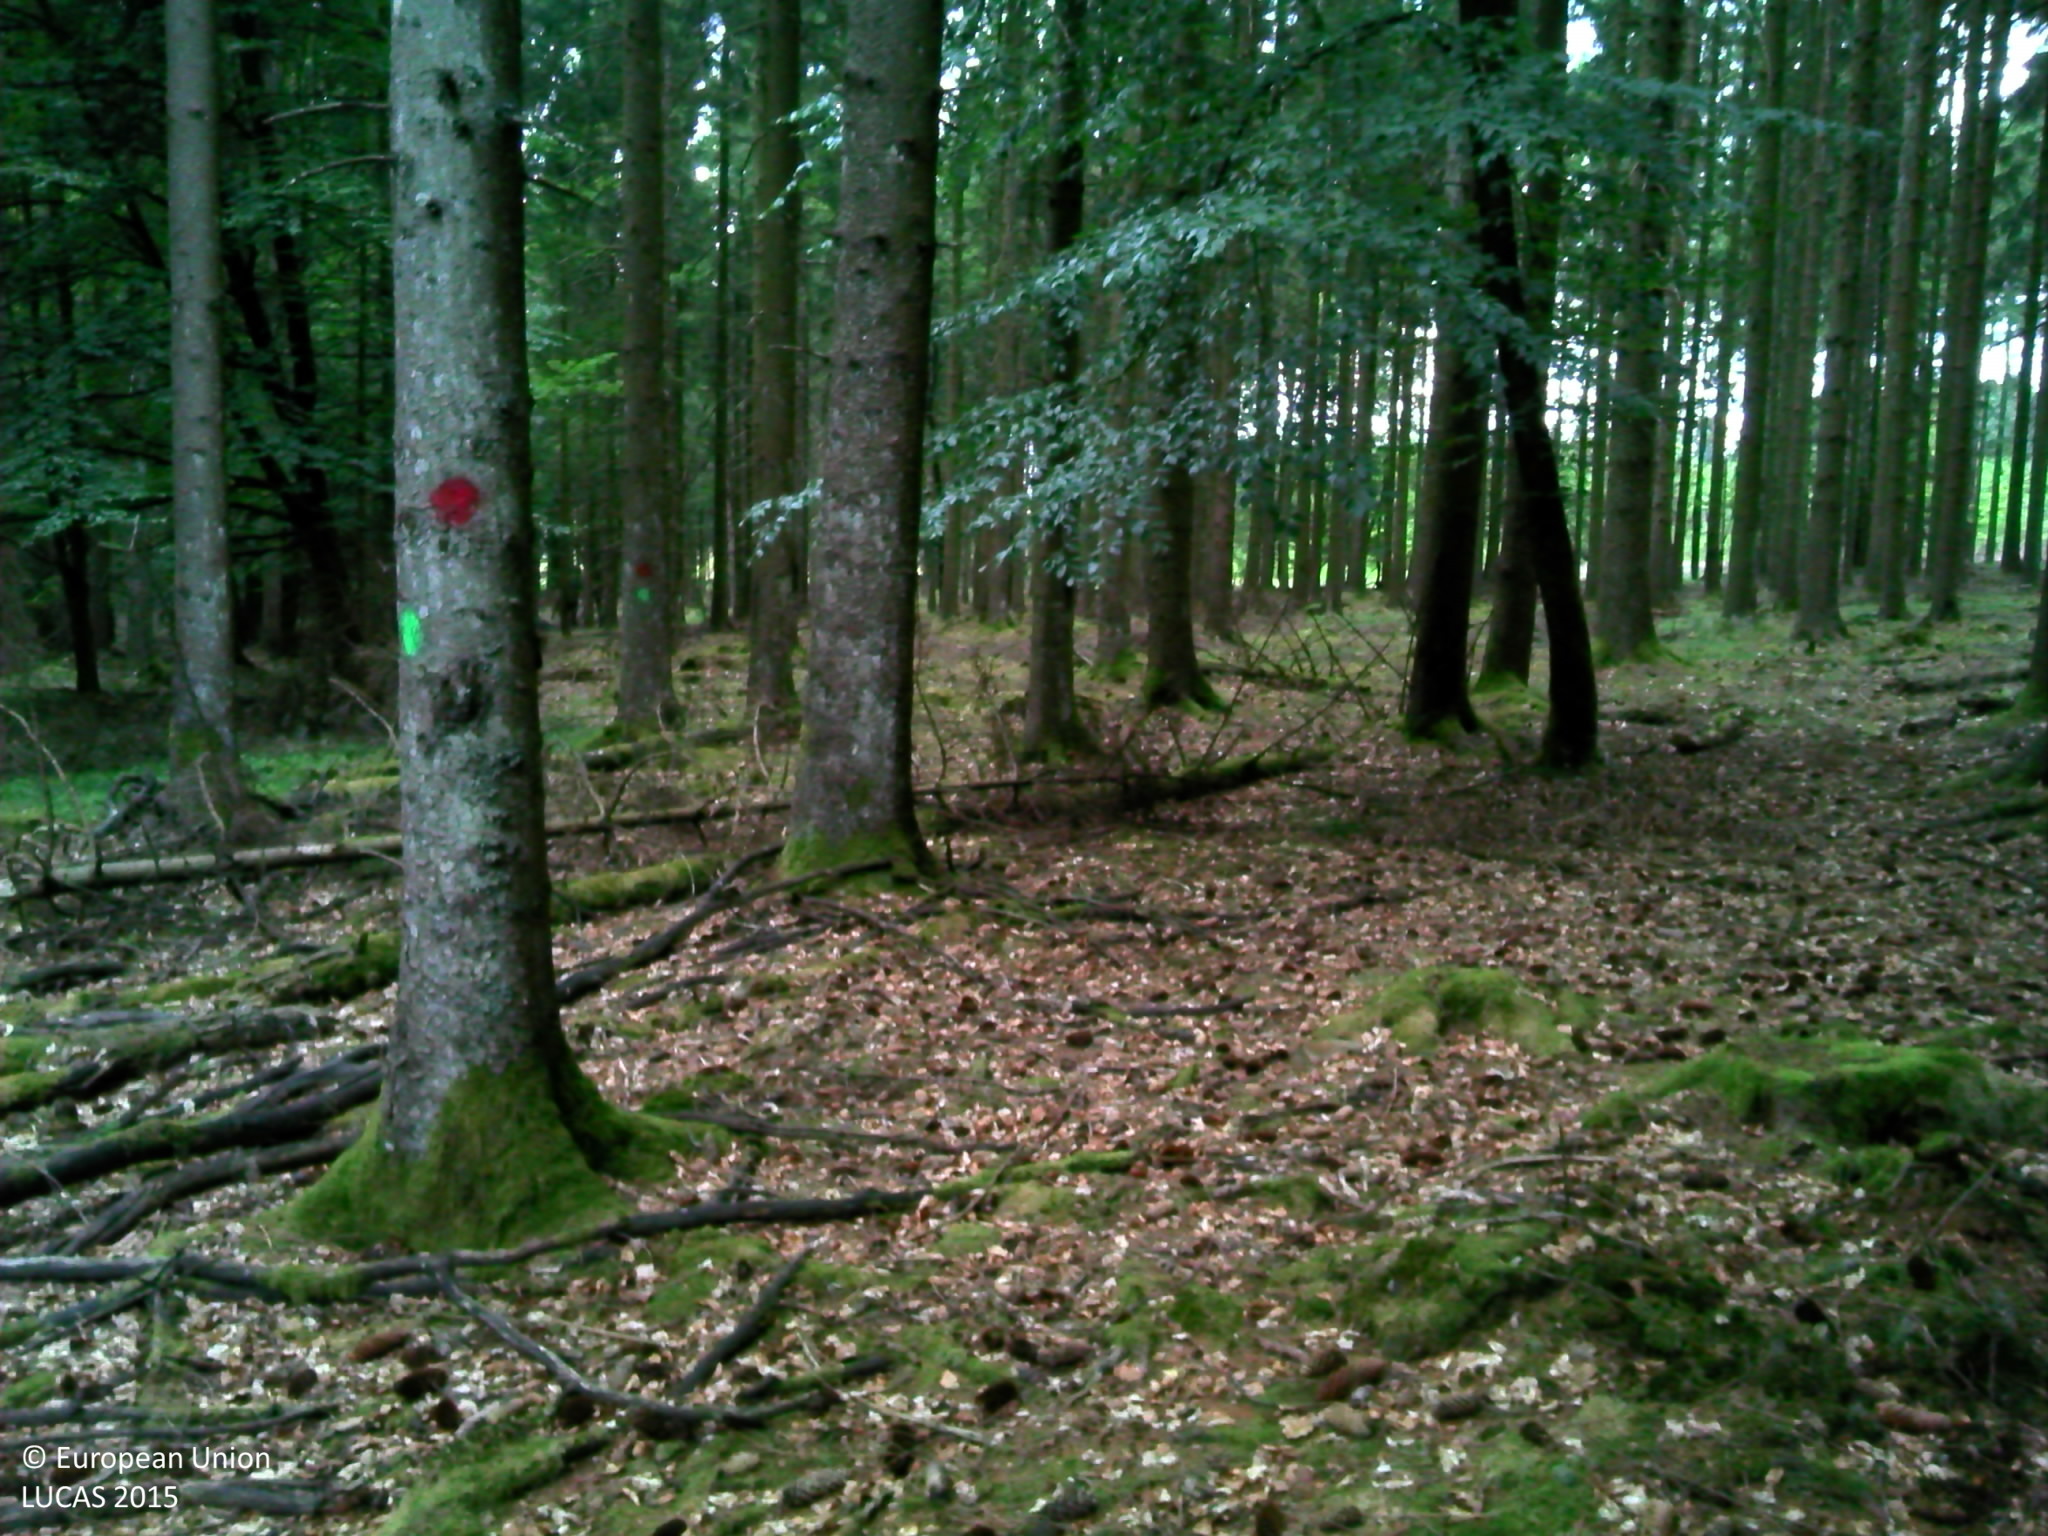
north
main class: Woodland
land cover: Spruce dominated coniferous woodland
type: hemiboreal forest and nemoral coniferous forest and mixed broadleaved-coniferous forest
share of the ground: > 75 %
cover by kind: coniferous forest trees 100 %
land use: Forestry
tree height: > 5 m
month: July
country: BE
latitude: 50.2132
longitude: 5.7526
